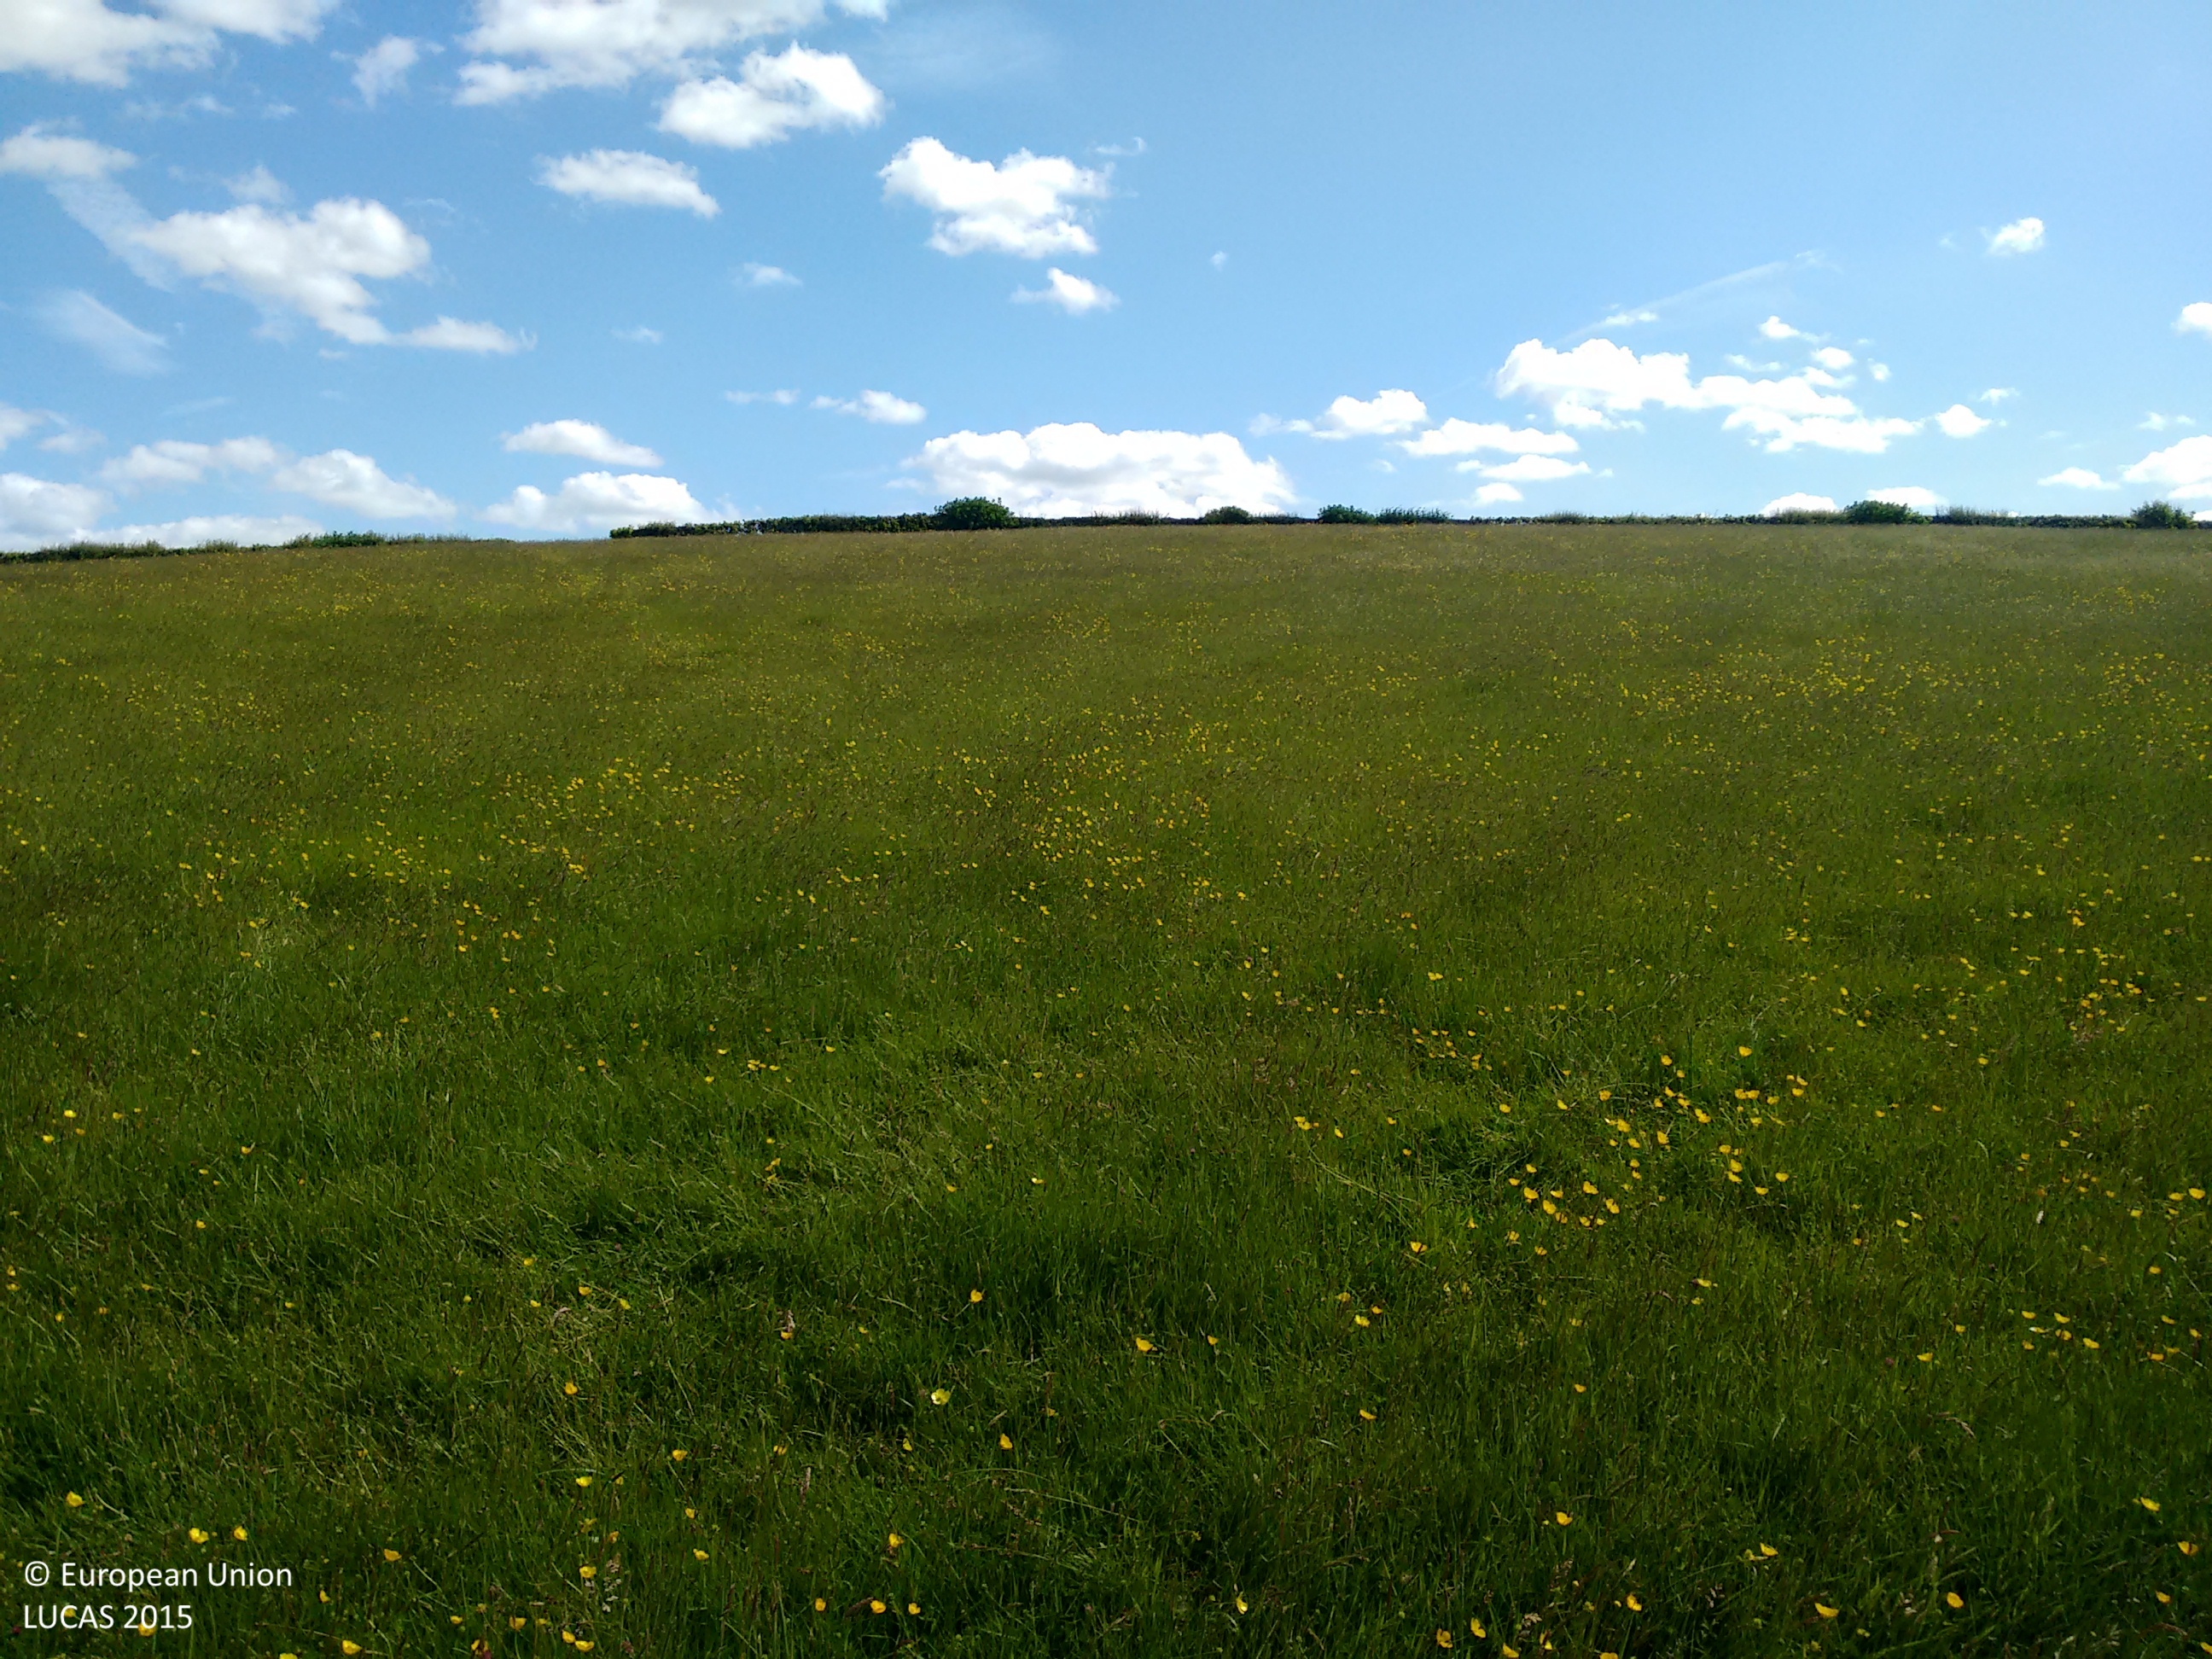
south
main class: Grassland
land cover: Grassland without tree/shrub cover
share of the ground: > 75 %
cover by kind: herbaceous plants 100 %
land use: Agriculture (excluding fallow land and kitchen gardens)
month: June
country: GB
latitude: 50.9733
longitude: 0.6166
